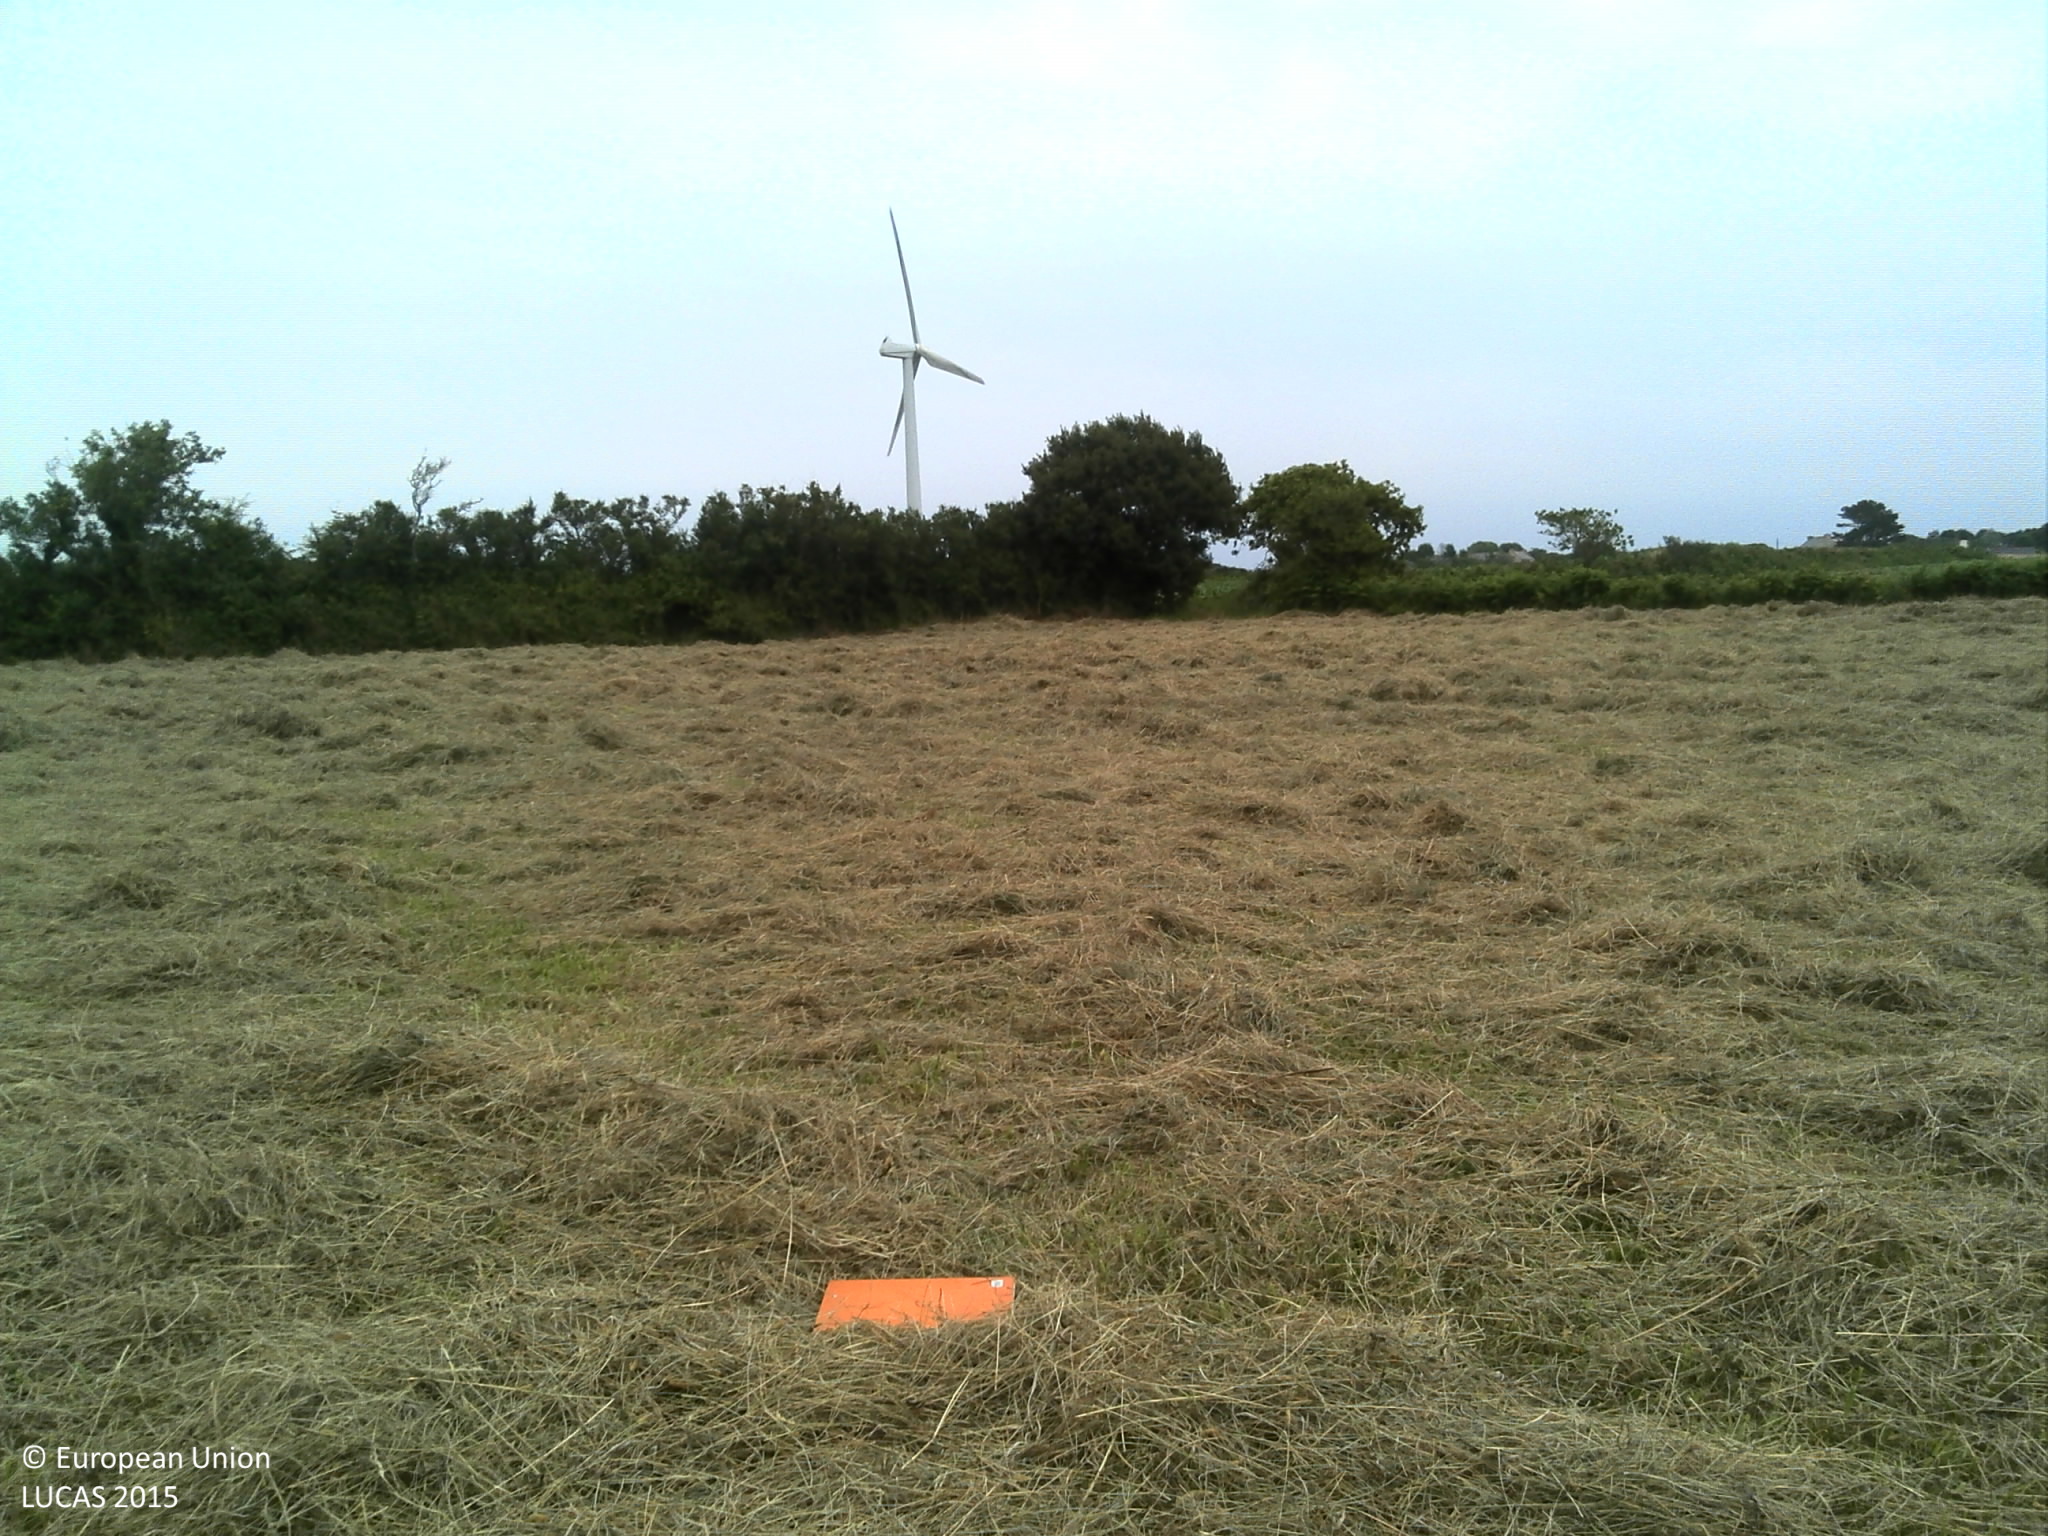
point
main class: Grassland
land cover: Grassland without tree/shrub cover
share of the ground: > 75 %
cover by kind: herbaceous plants 100 %
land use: Agriculture (excluding fallow land and kitchen gardens)
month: July
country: FR
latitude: 48.3938
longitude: -4.7578
